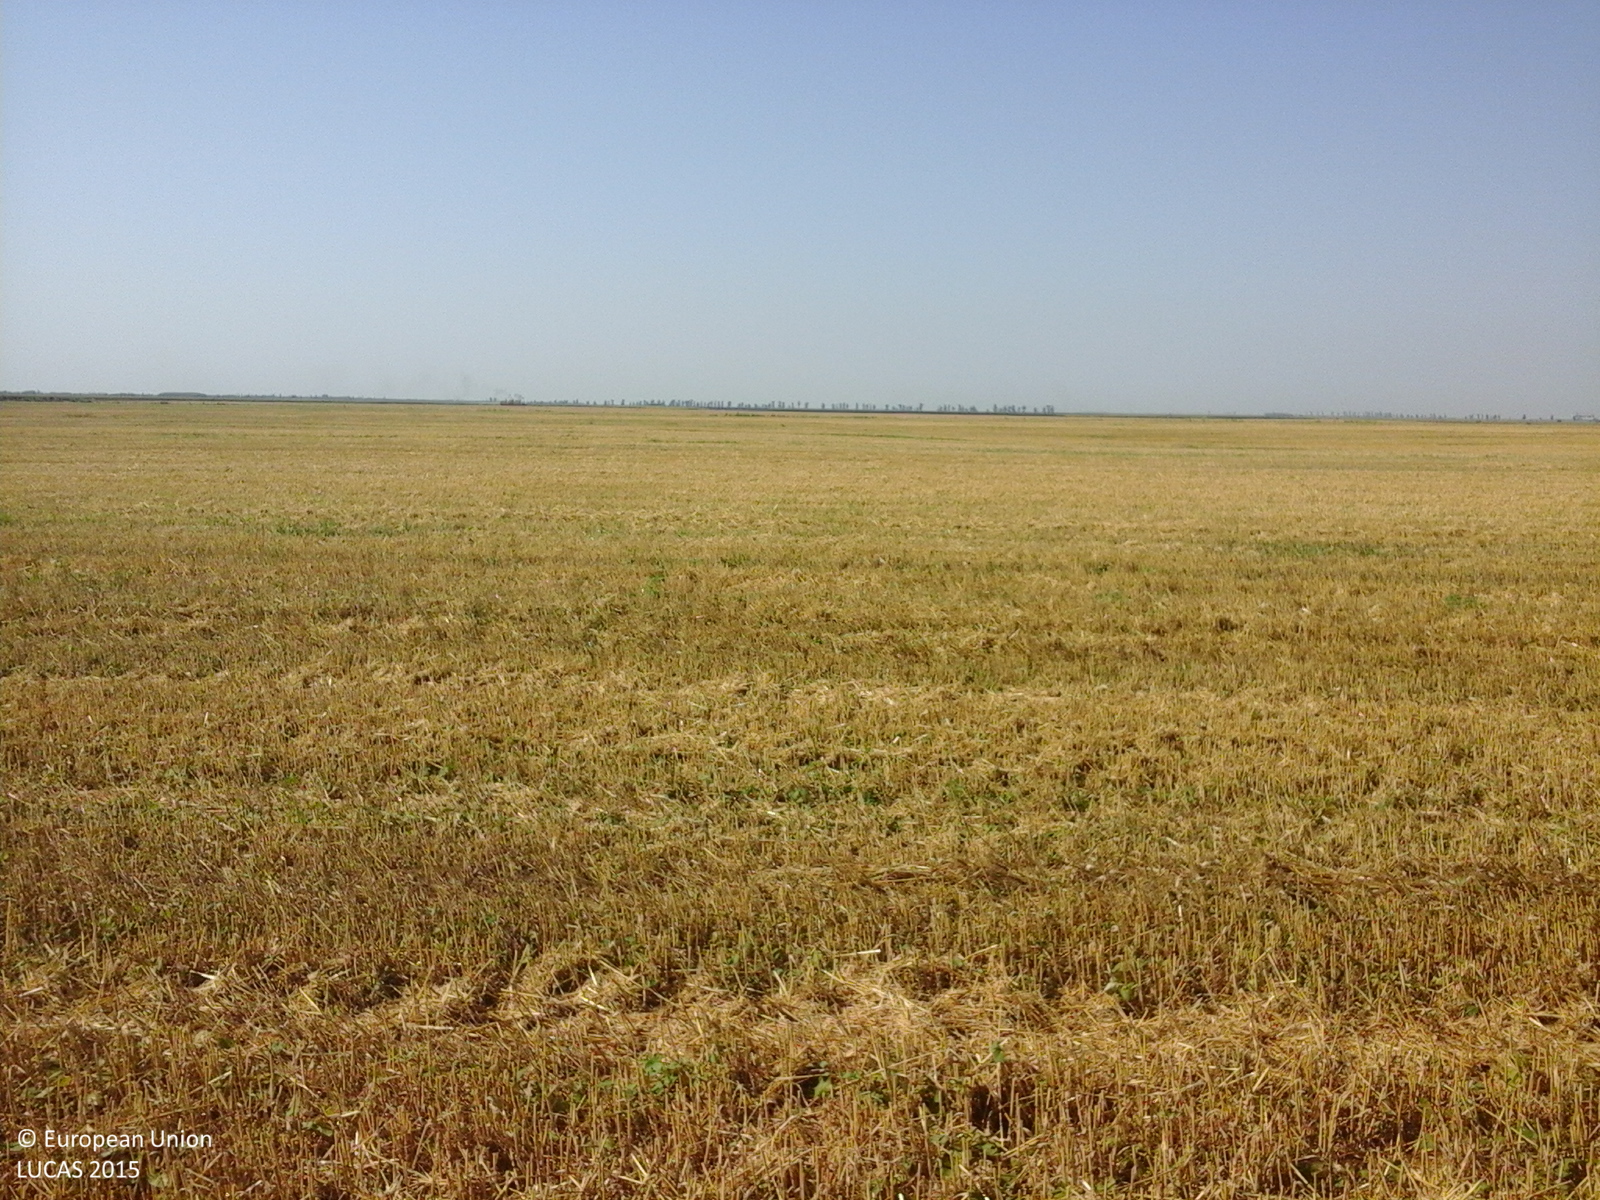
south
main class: Cropland
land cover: Maize
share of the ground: > 75 %
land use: Agriculture (excluding fallow land and kitchen gardens)
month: July
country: RO
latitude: 44.7585
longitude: 27.1004
